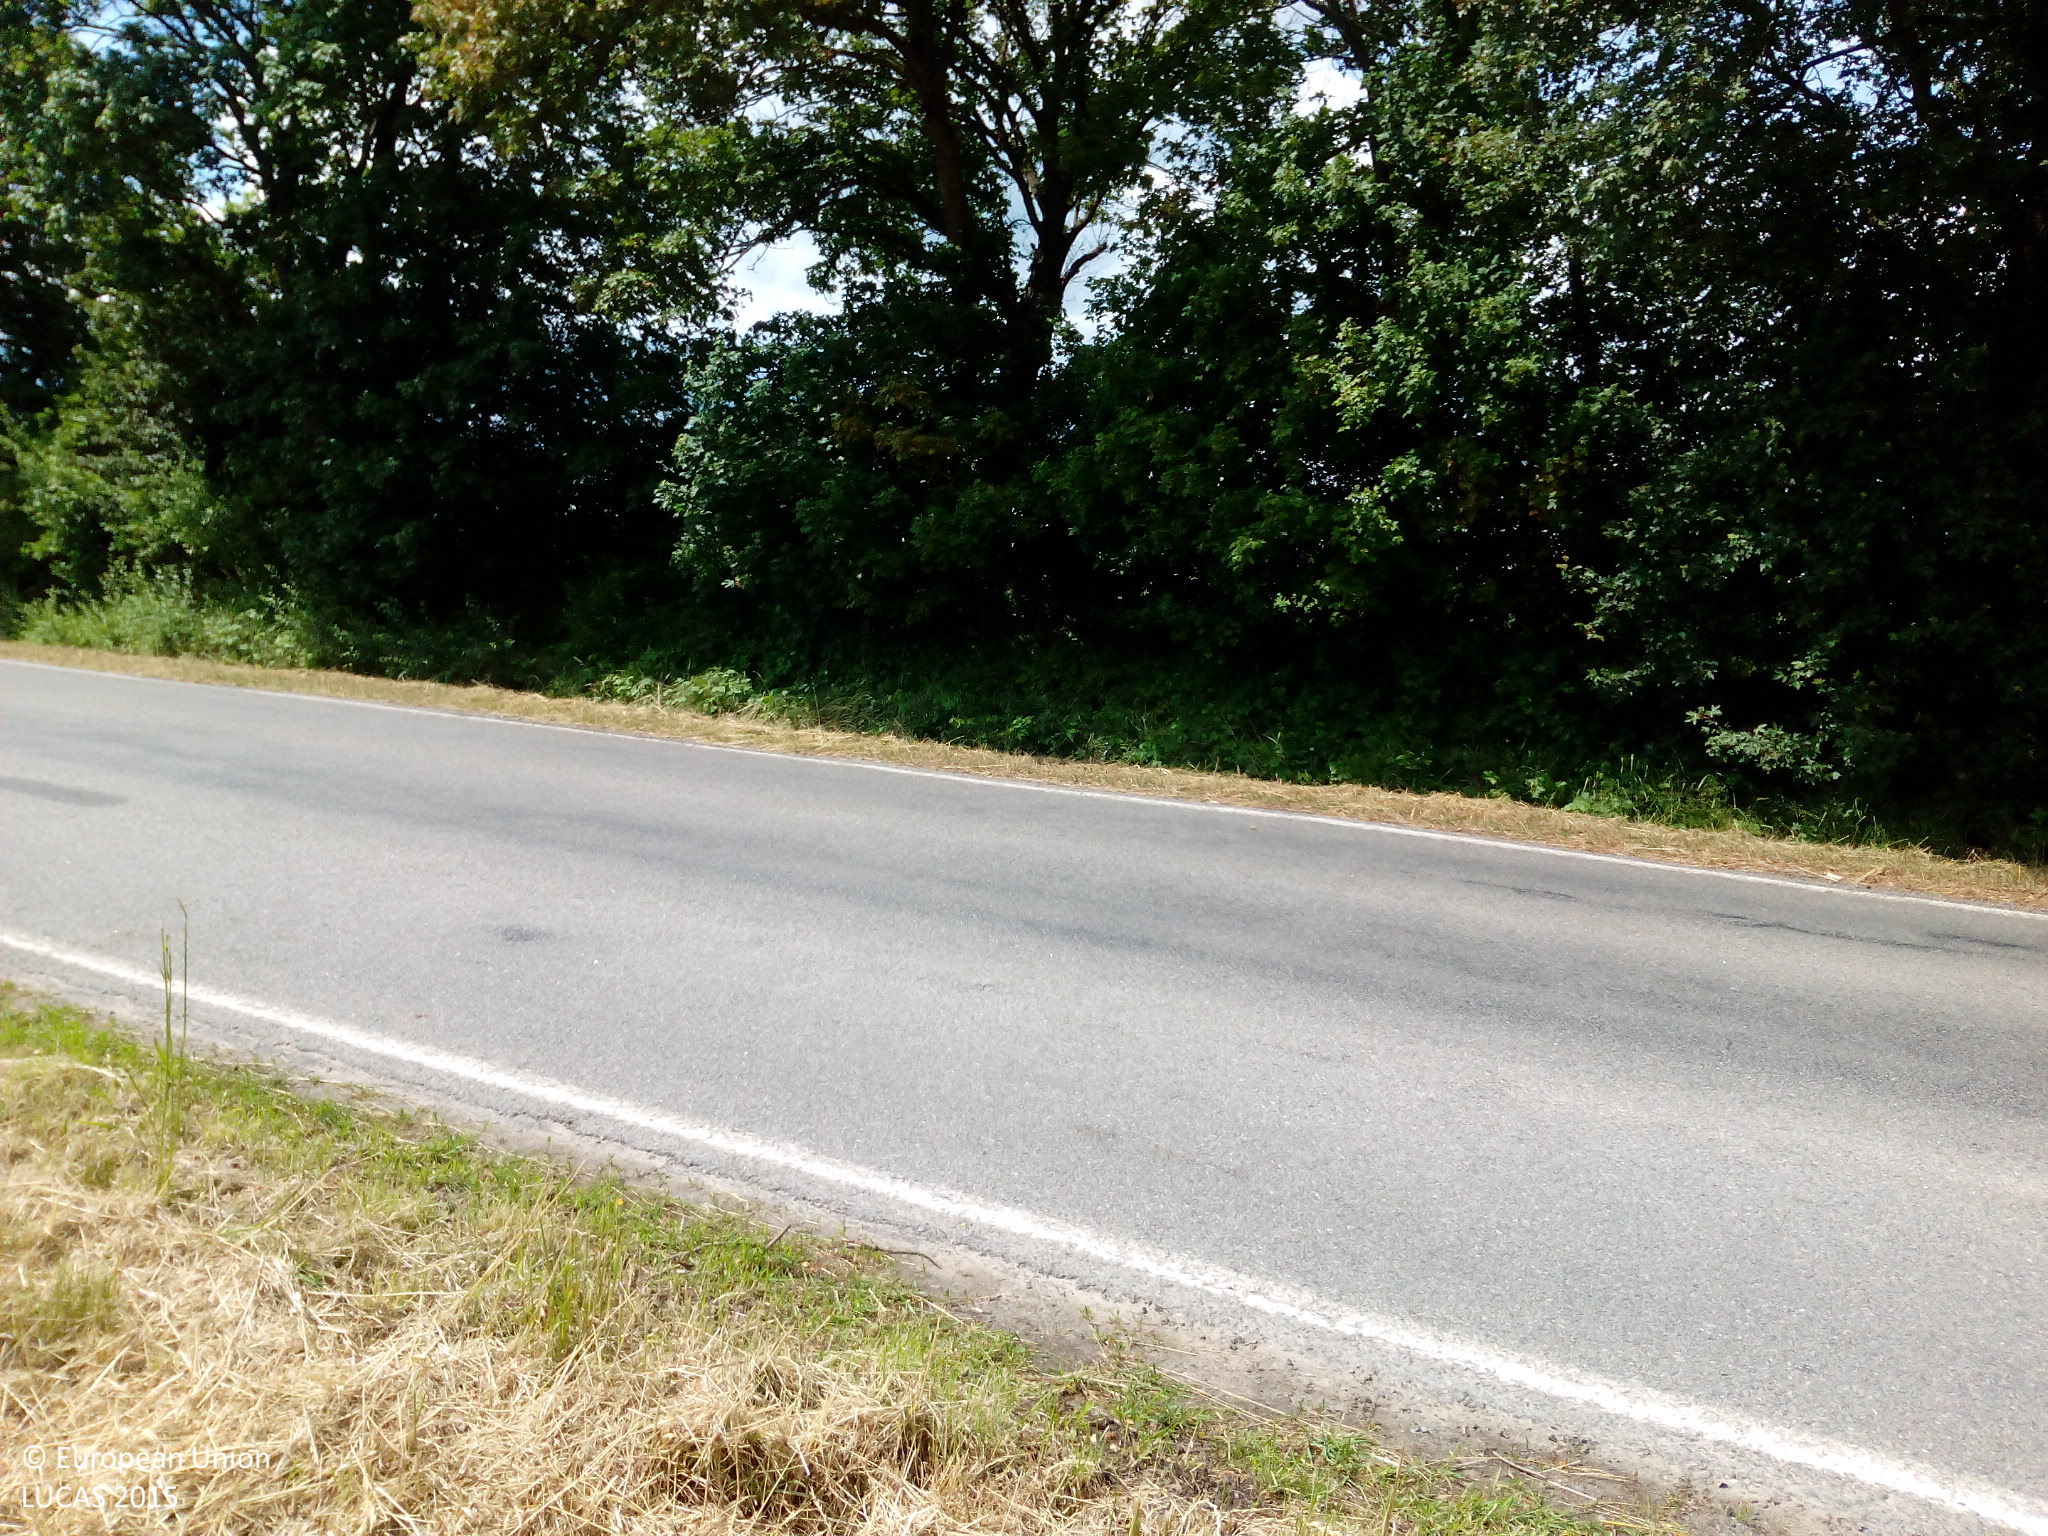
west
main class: Cropland
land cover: Rape and turnip rape
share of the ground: > 75 %
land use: Agriculture (excluding fallow land and kitchen gardens)
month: June
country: DE
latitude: 53.8277
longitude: 11.1693
